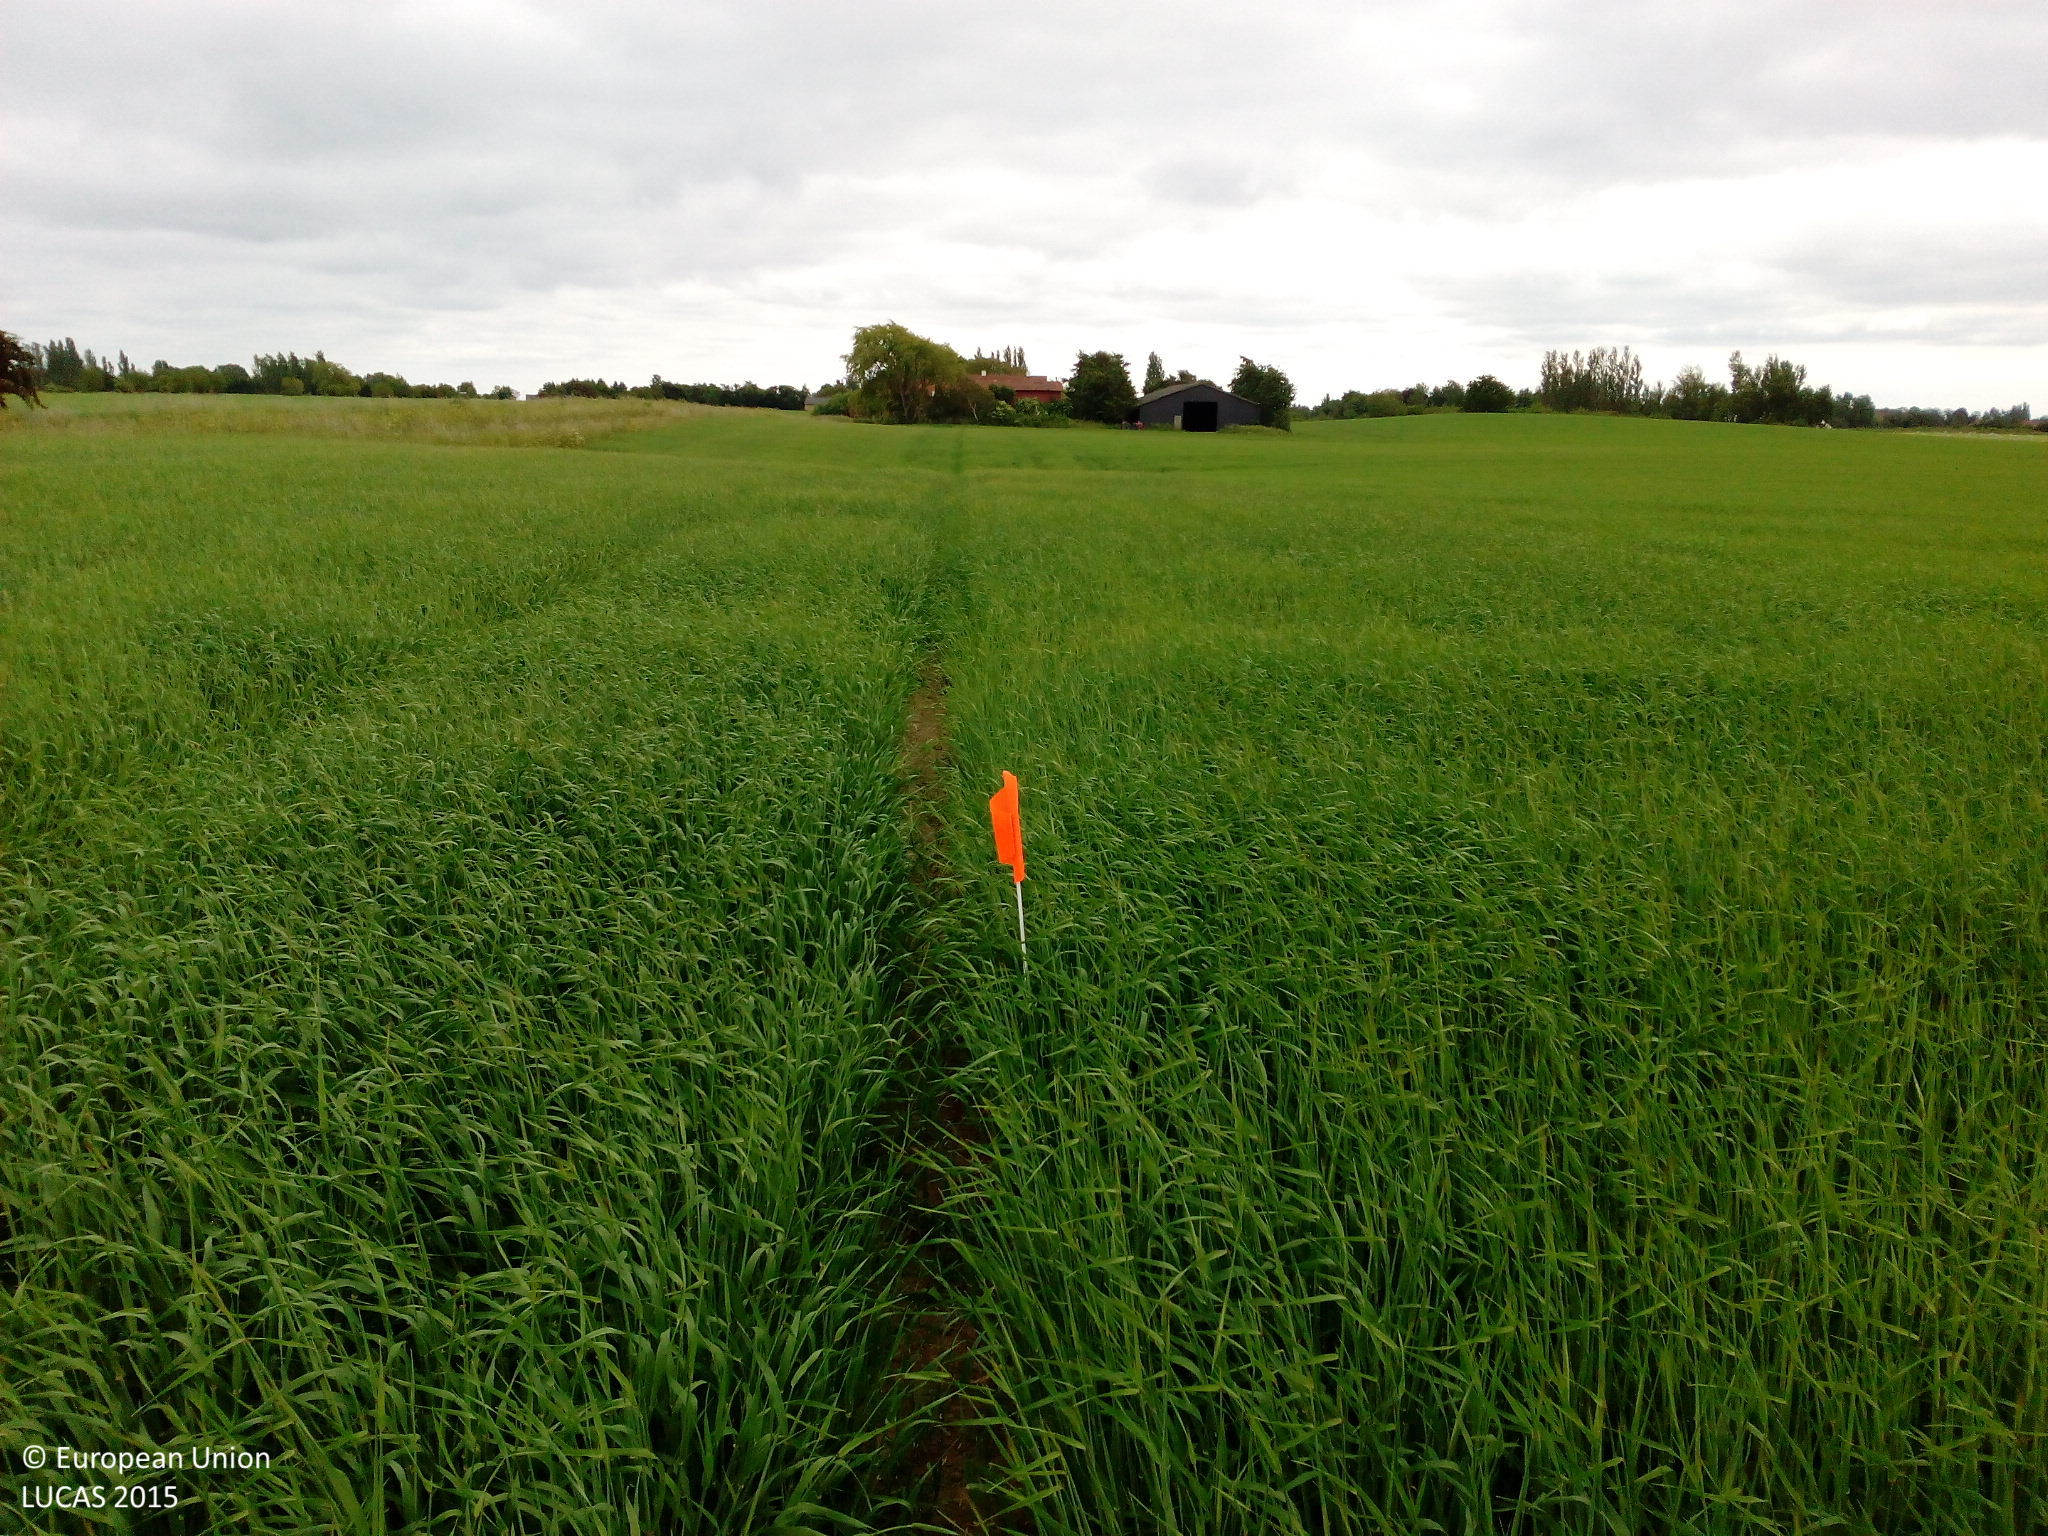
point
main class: Cropland
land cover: Barley
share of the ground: > 75 %
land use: Agriculture (excluding fallow land and kitchen gardens)
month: June
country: DK
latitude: 54.9575
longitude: 11.4201
